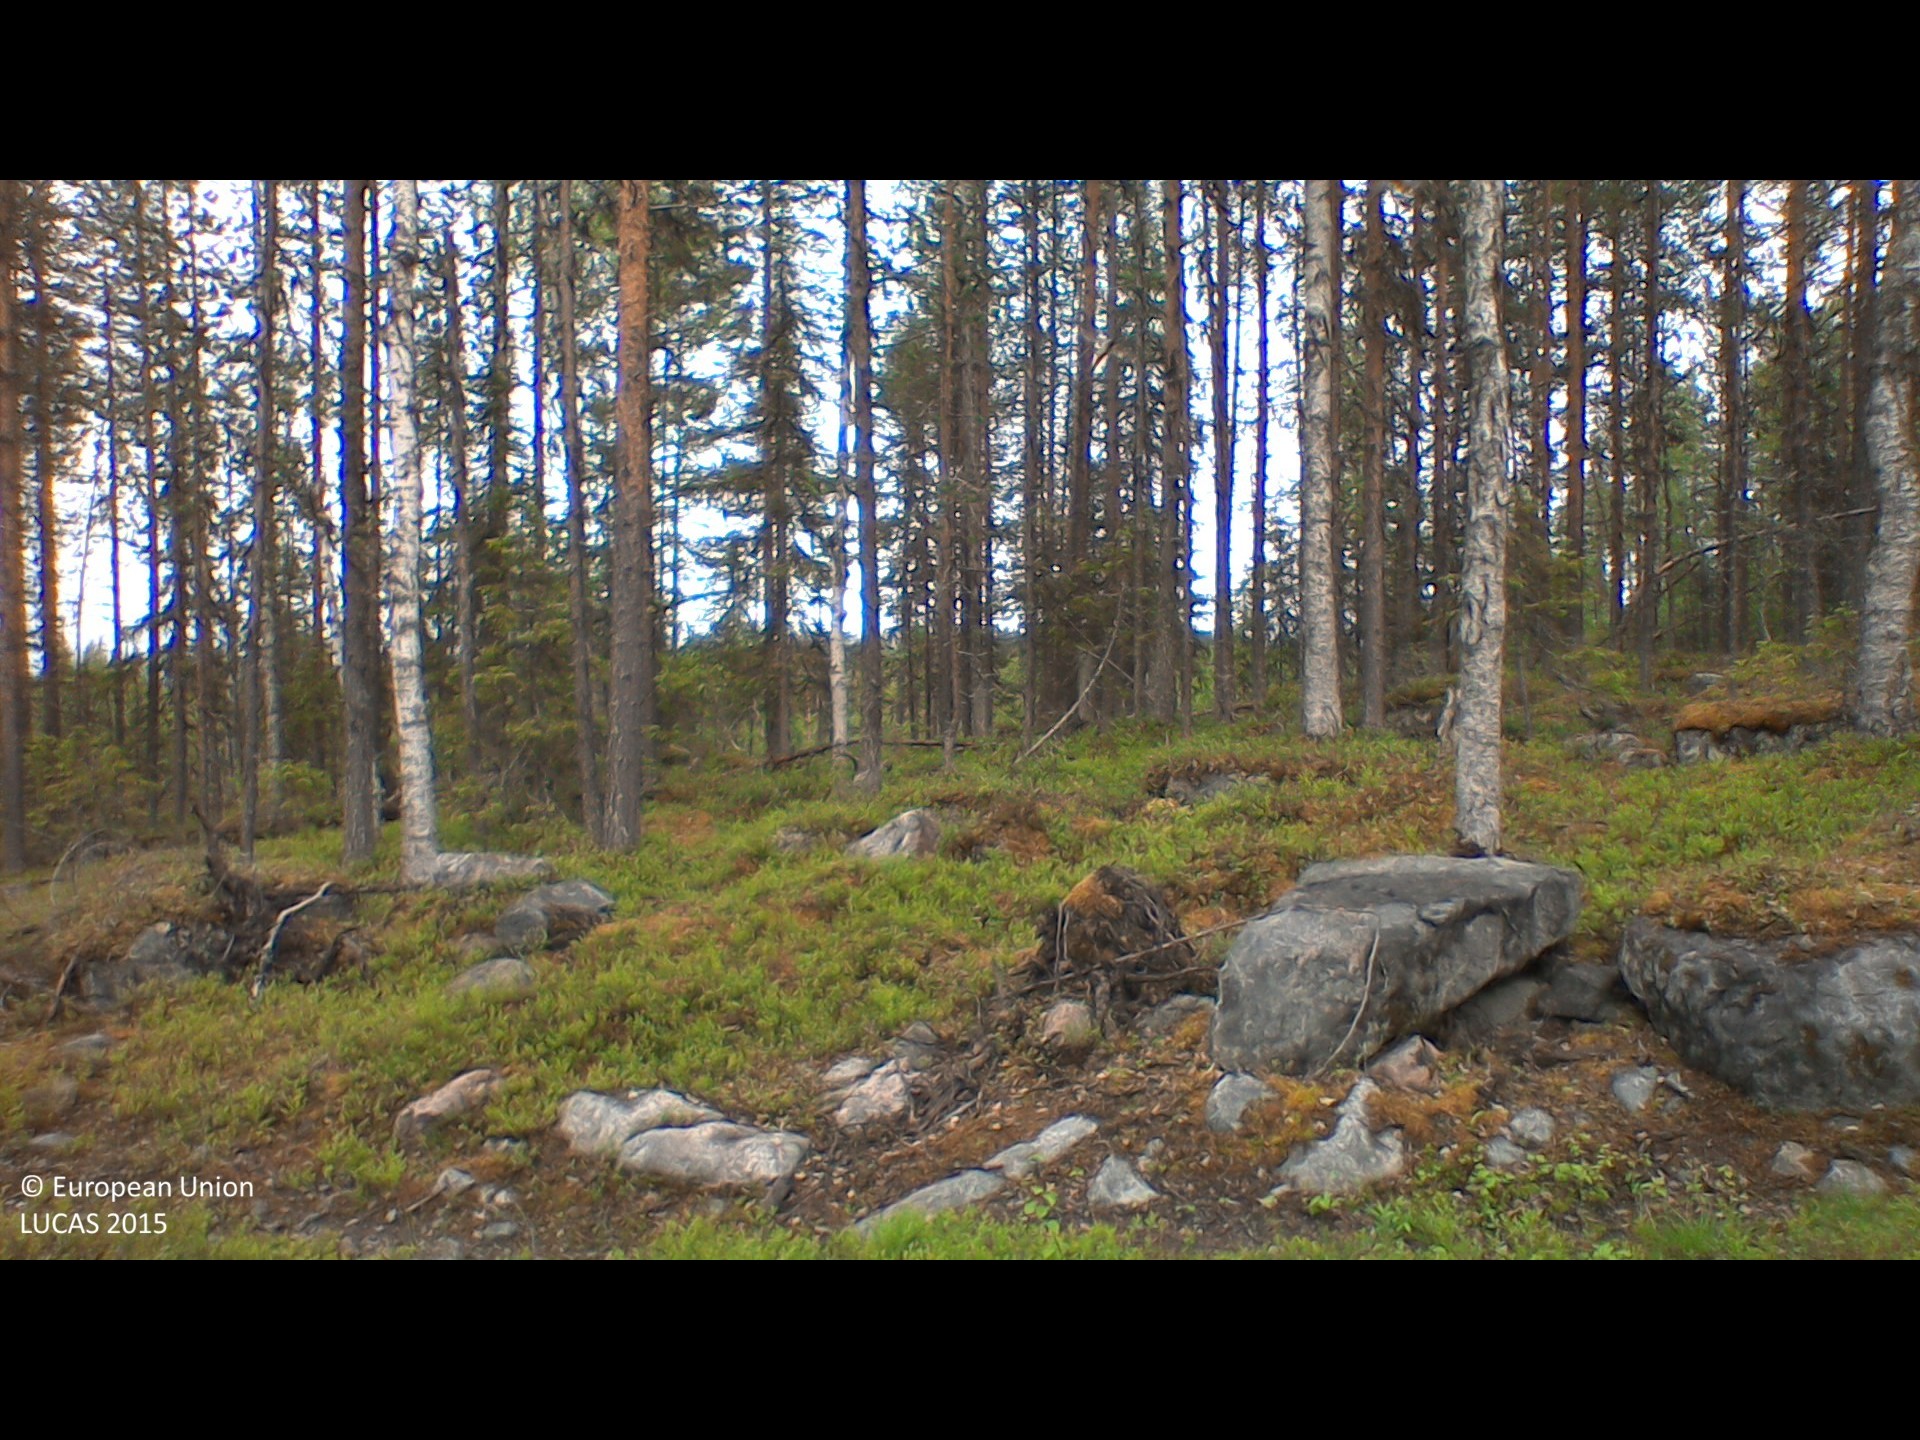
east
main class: Woodland
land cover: Pine dominated mixed woodland
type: boreal forest
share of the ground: 25 - 50 %
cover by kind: shrubs 70 %, coniferous forest trees 15 %, broadleaved forest trees 10 %, unconsolidated bare surface 5 %
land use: Forestry
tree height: > 5 m
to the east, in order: Pine dominated mixed woodland; Tracks; Pine dominated mixed woodland; Shrubland with sparse tree cover; Pine dominated coniferous woodland; Ditches and canals; Groves; Paved roads, cycling and walking lanes; Groves; Ditches and canals; Spruce dominated mixed woodland; Spruce dominated coniferous woodland; Spruce dominated mixed woodland
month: July
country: SE
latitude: 66.7591
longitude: 23.0785
